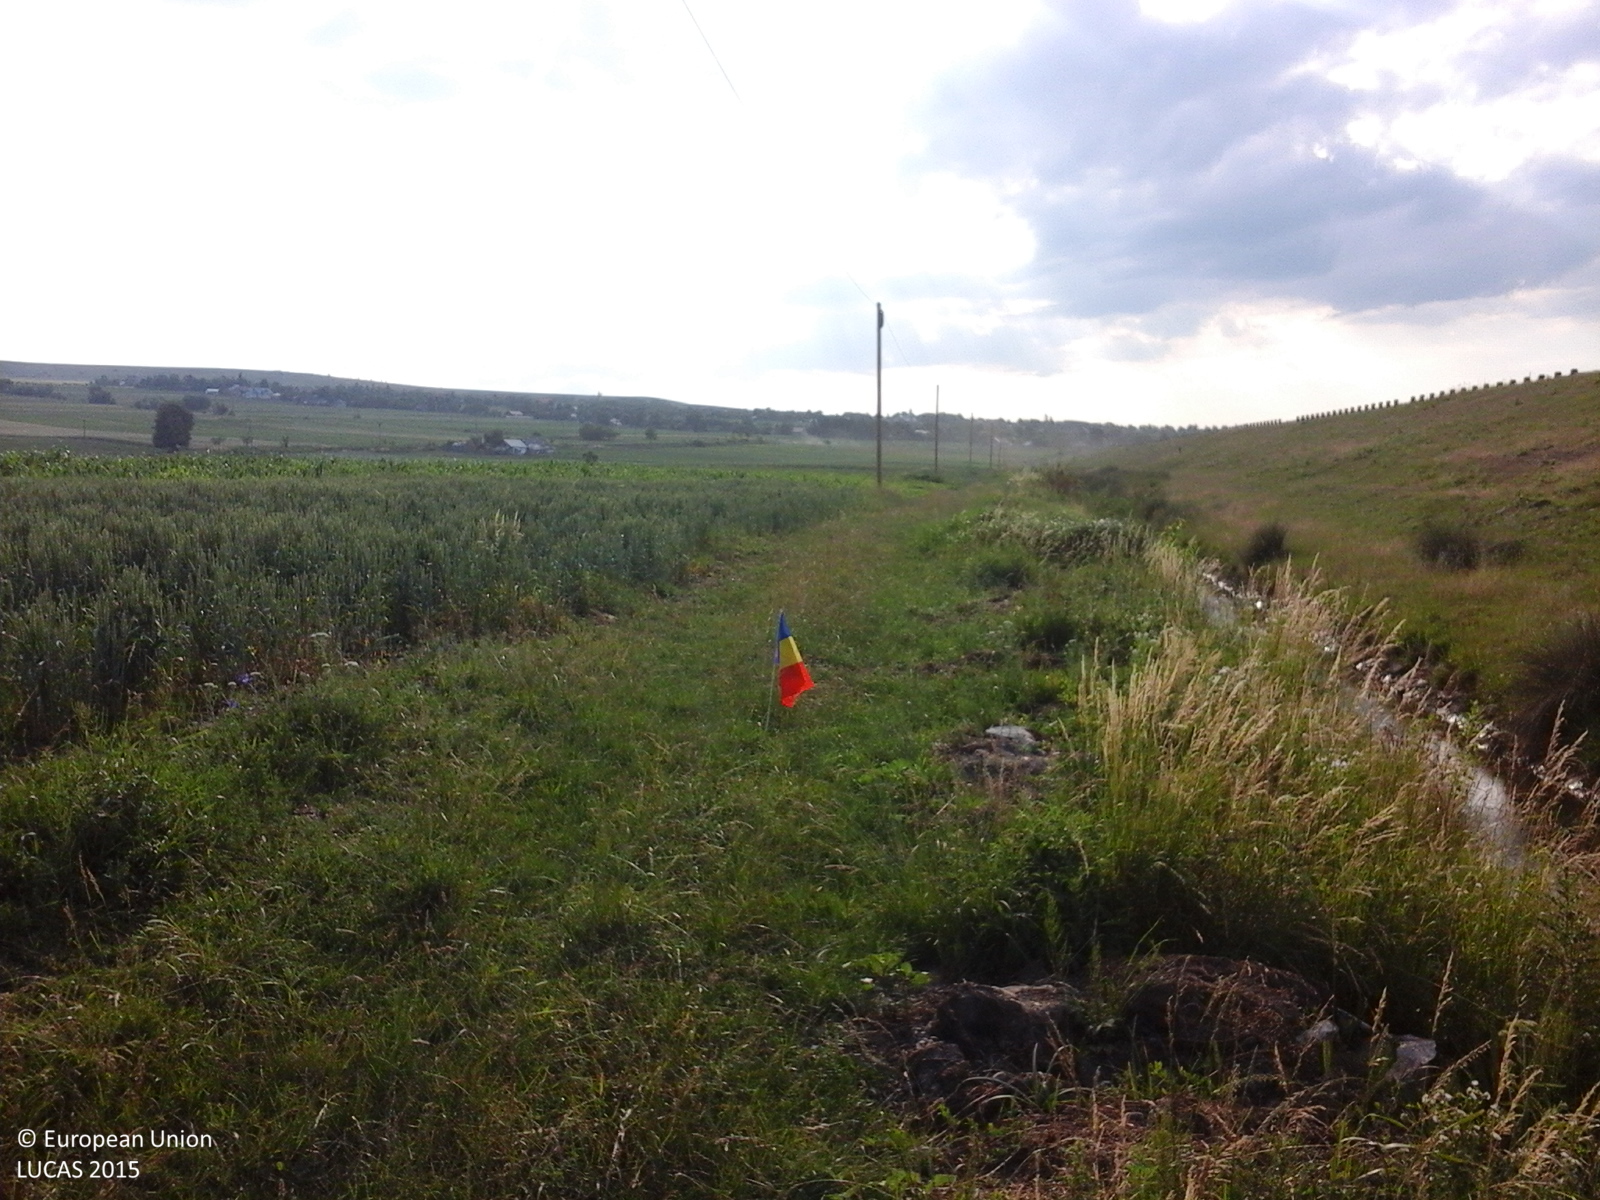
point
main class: Grassland
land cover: Grassland without tree/shrub cover
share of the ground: > 75 %
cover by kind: herbaceous plants 100 %
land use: Agriculture (excluding fallow land and kitchen gardens)
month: June
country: RO
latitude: 47.7804
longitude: 26.3558
